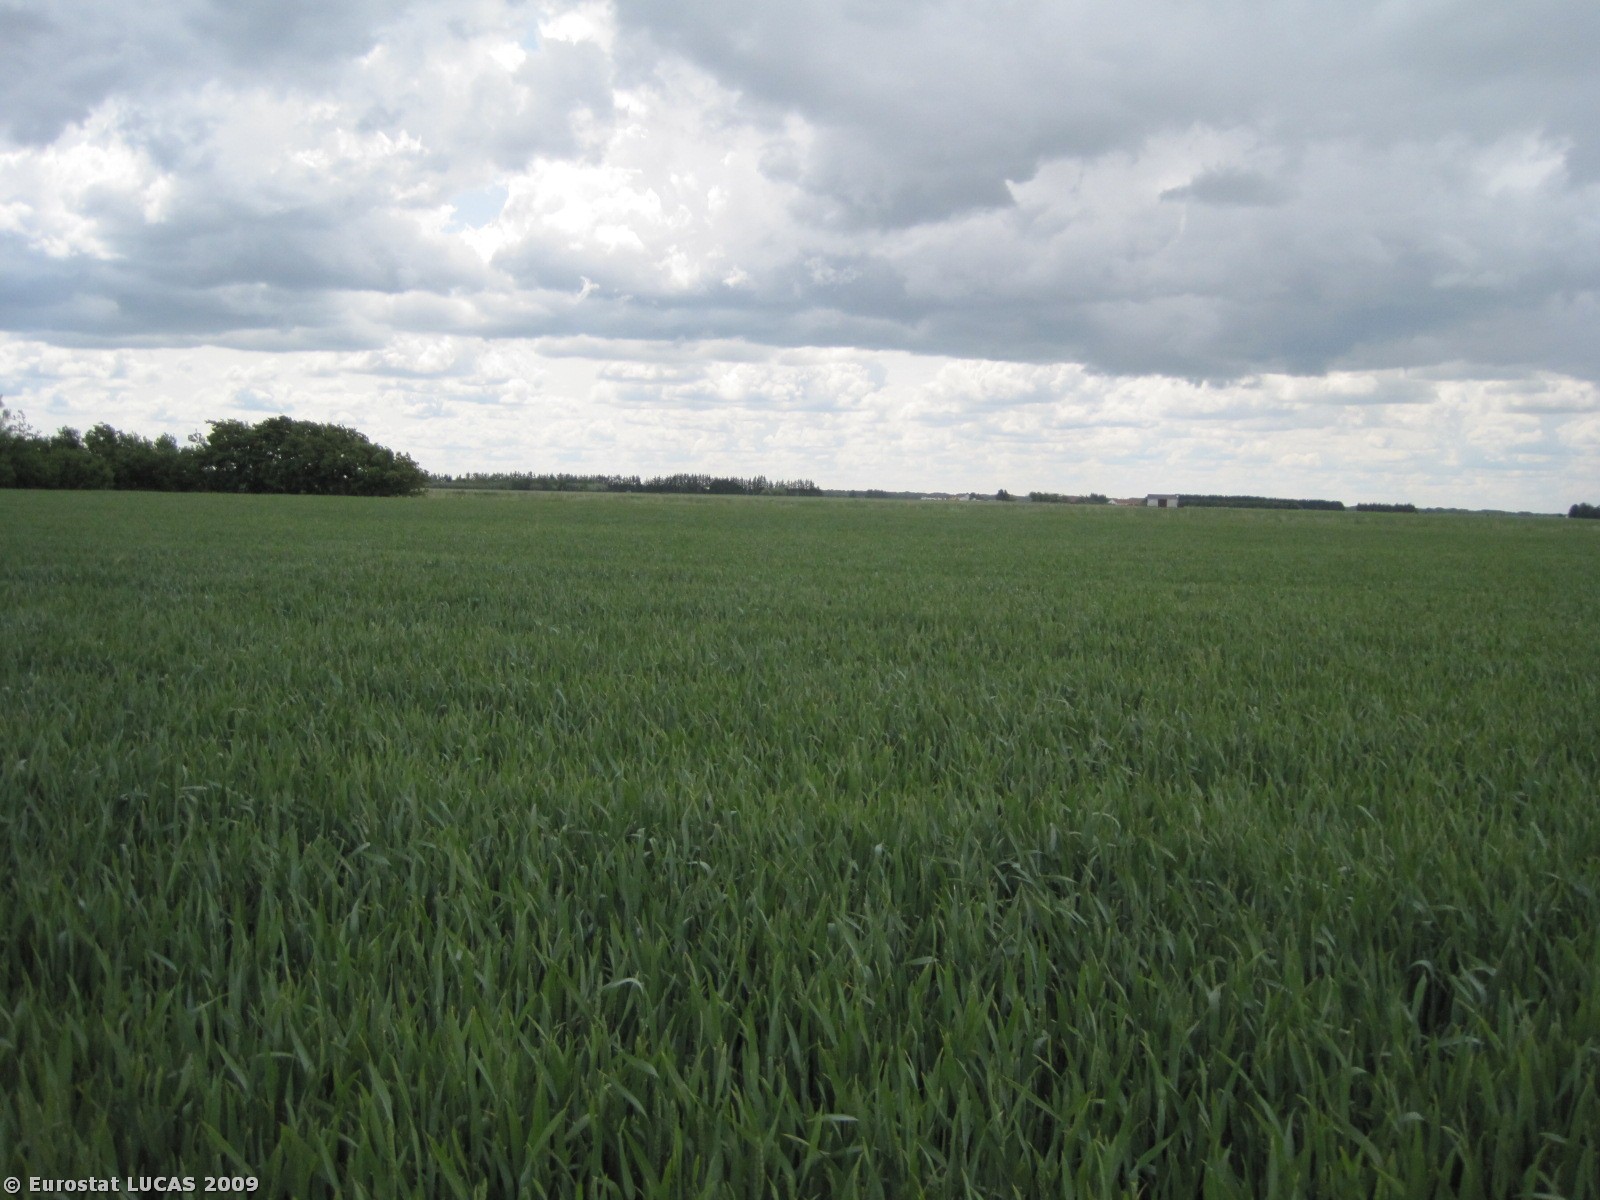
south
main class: Cropland
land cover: Common wheat
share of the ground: > 75 %
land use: Agriculture (excluding fallow land and kitchen gardens)
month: June
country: DK
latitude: 57.2662
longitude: 9.7848
